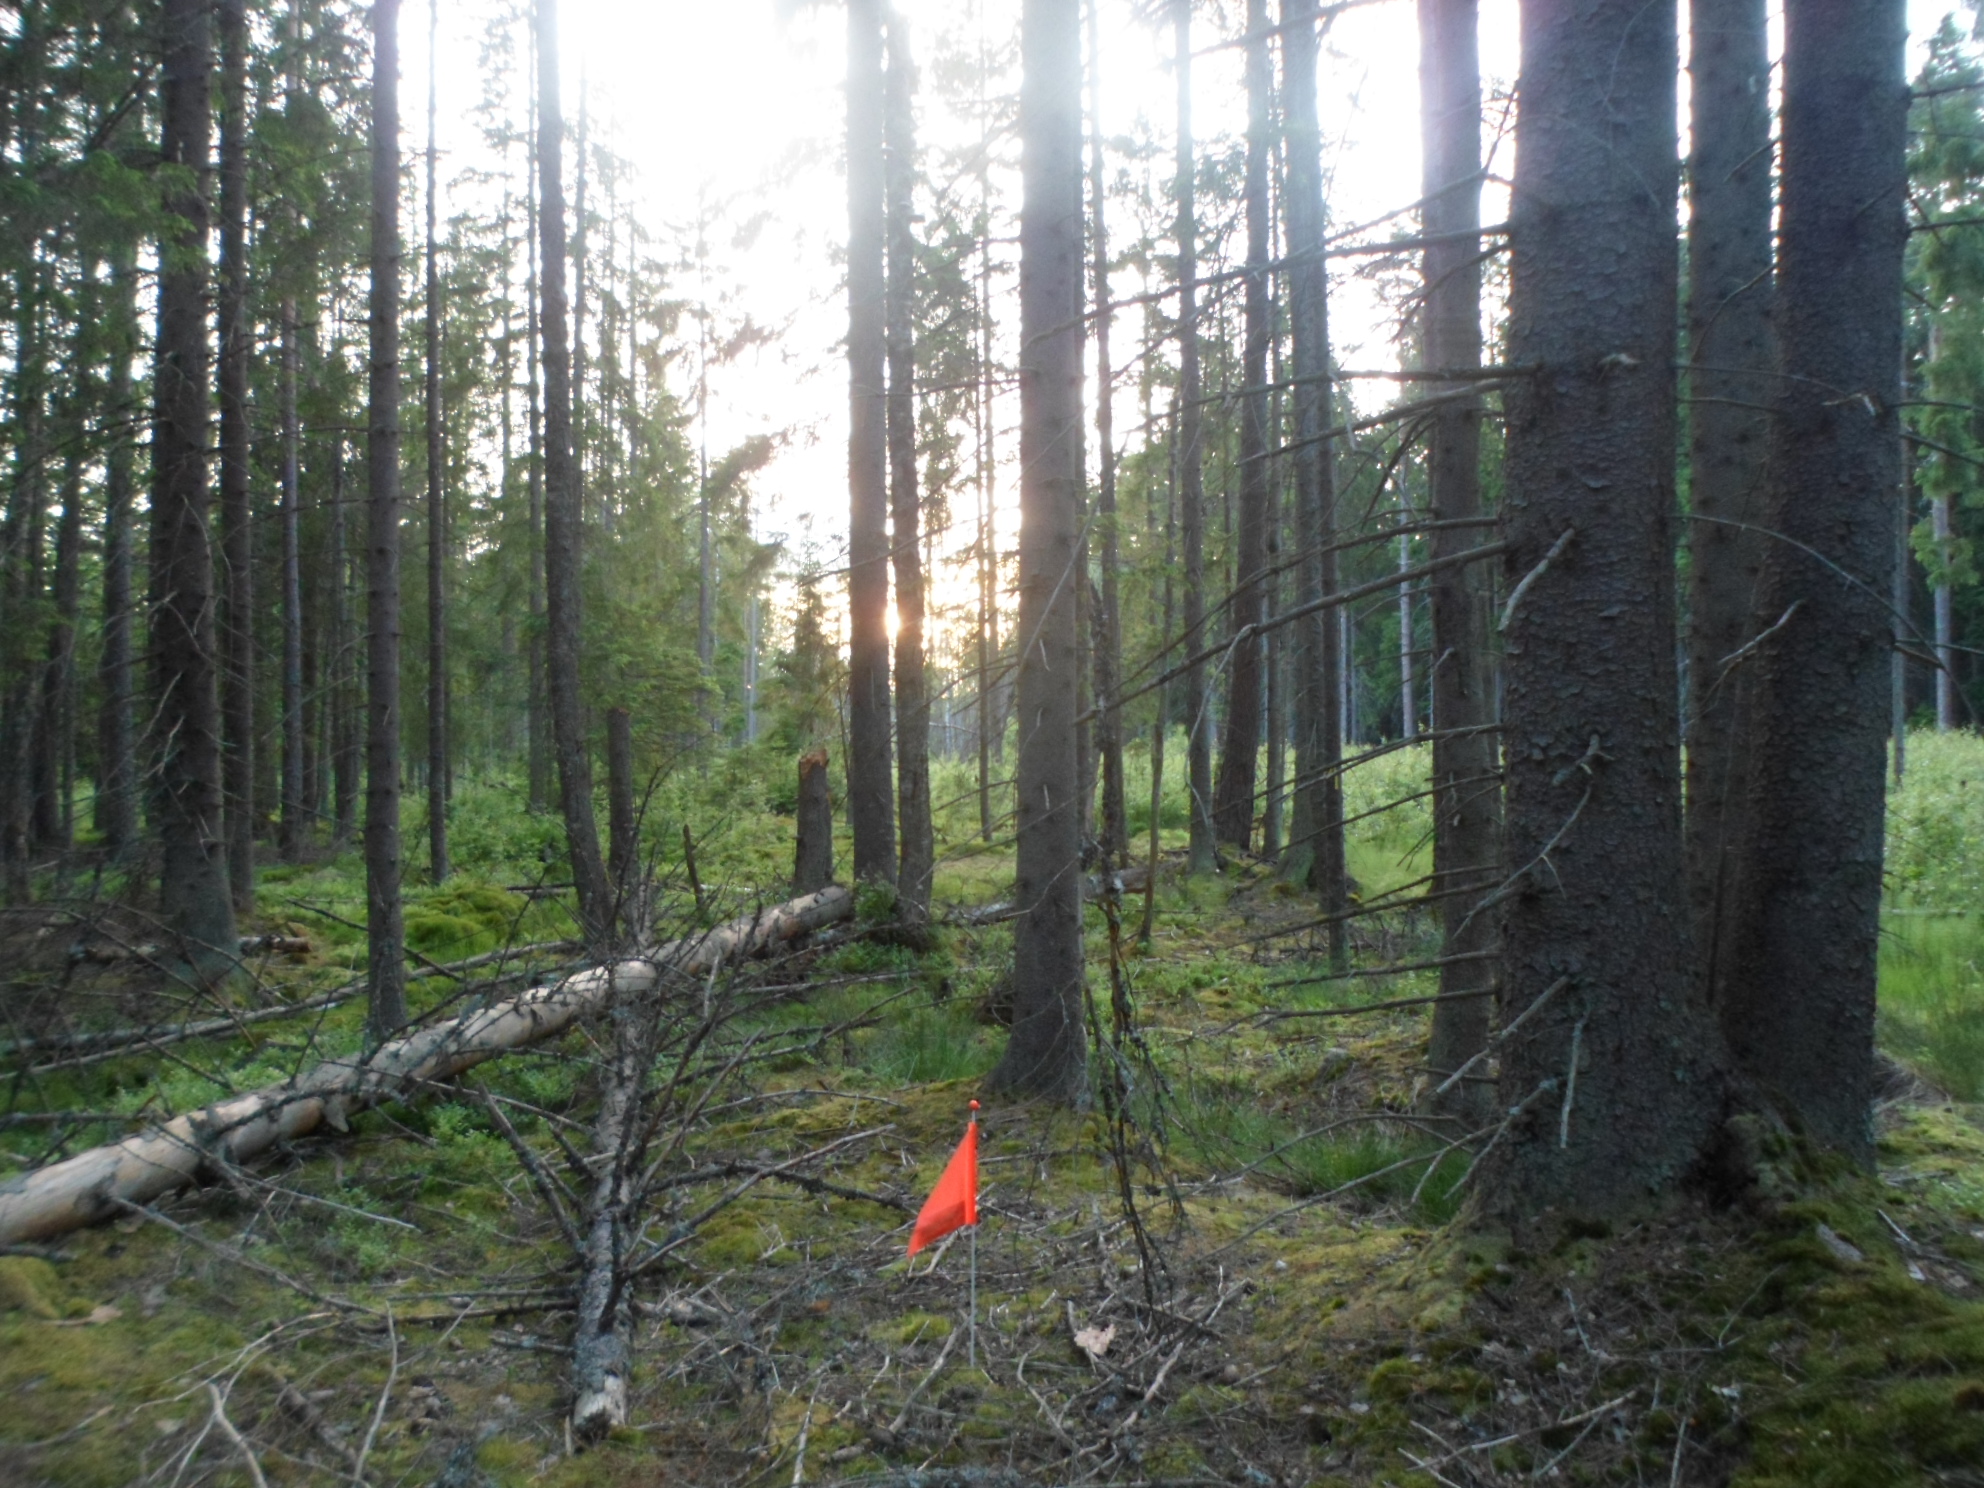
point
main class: Woodland
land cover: Spruce dominated coniferous woodland
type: boreal forest
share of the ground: 50 - 75 %
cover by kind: coniferous forest trees 55 %, shrubs 15 %, lichens and mosses 15 %, broadleaved forest trees 10 %, herbaceous plants 5 %
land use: Forestry
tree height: > 5 m
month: June
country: SE
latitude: 57.0479
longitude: 15.3879
